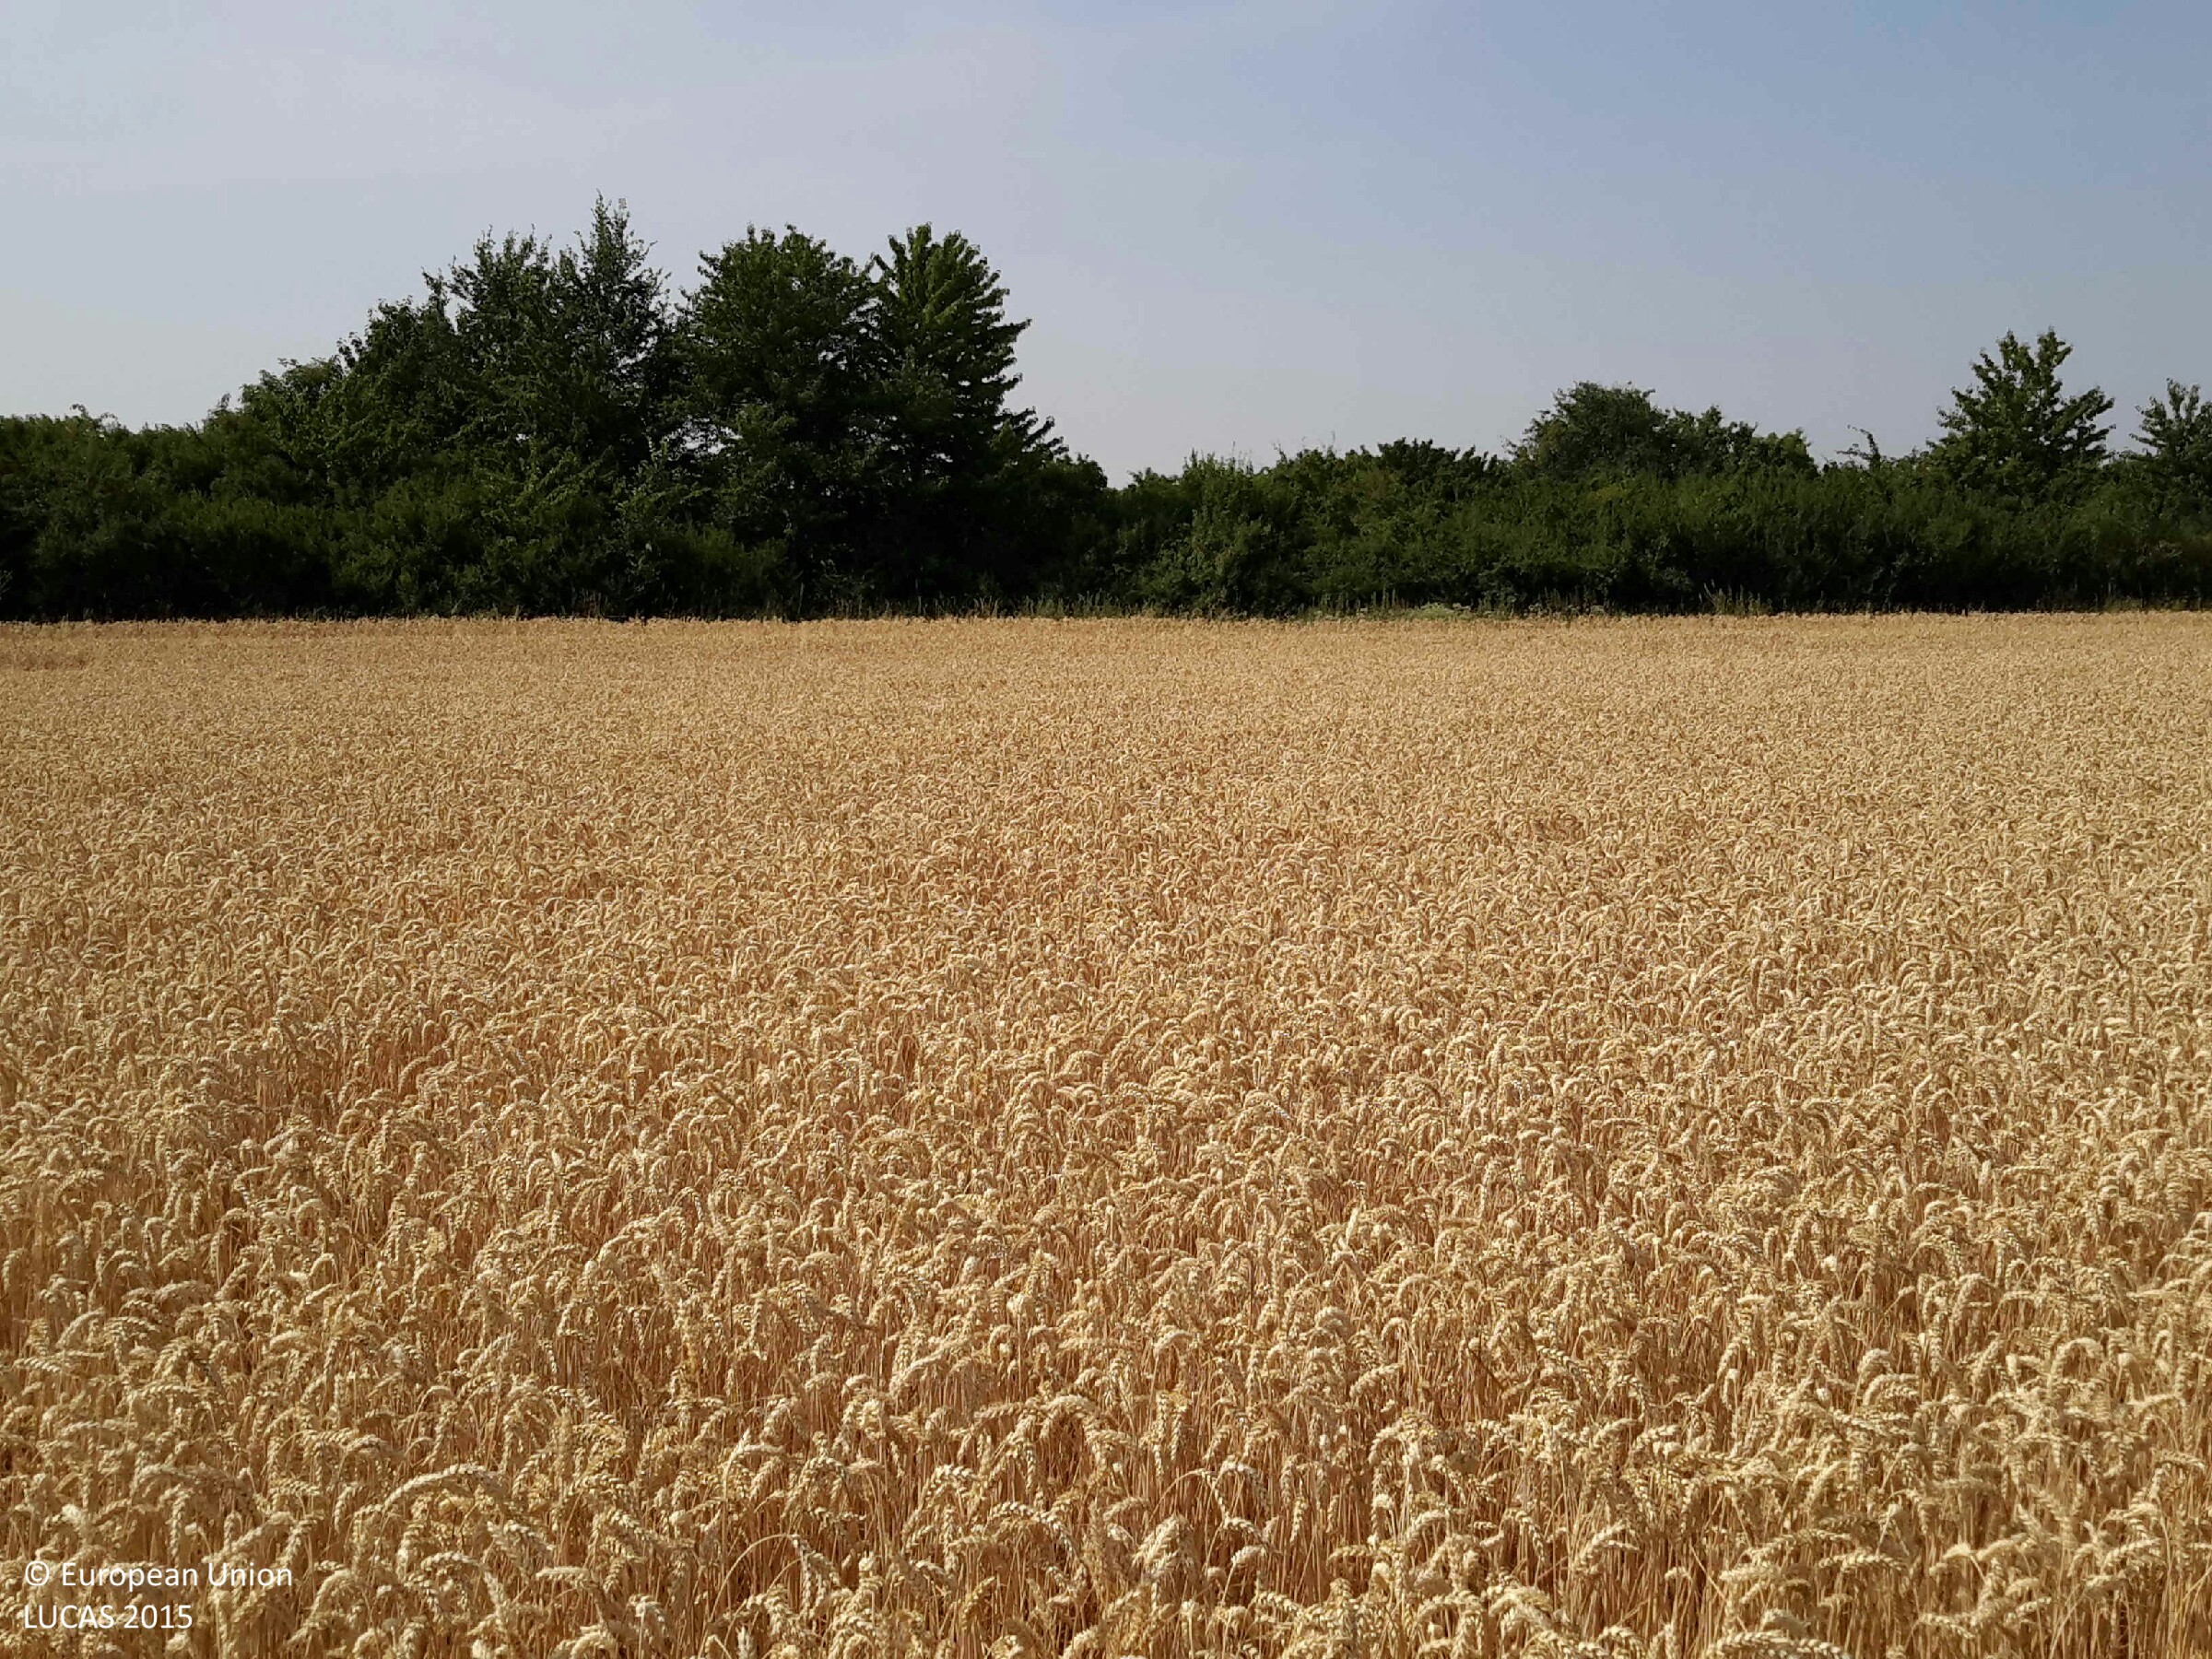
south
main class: Cropland
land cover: Common wheat
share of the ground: > 75 %
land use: Agriculture (excluding fallow land and kitchen gardens)
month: July
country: HU
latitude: 47.6062
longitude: 16.6690
